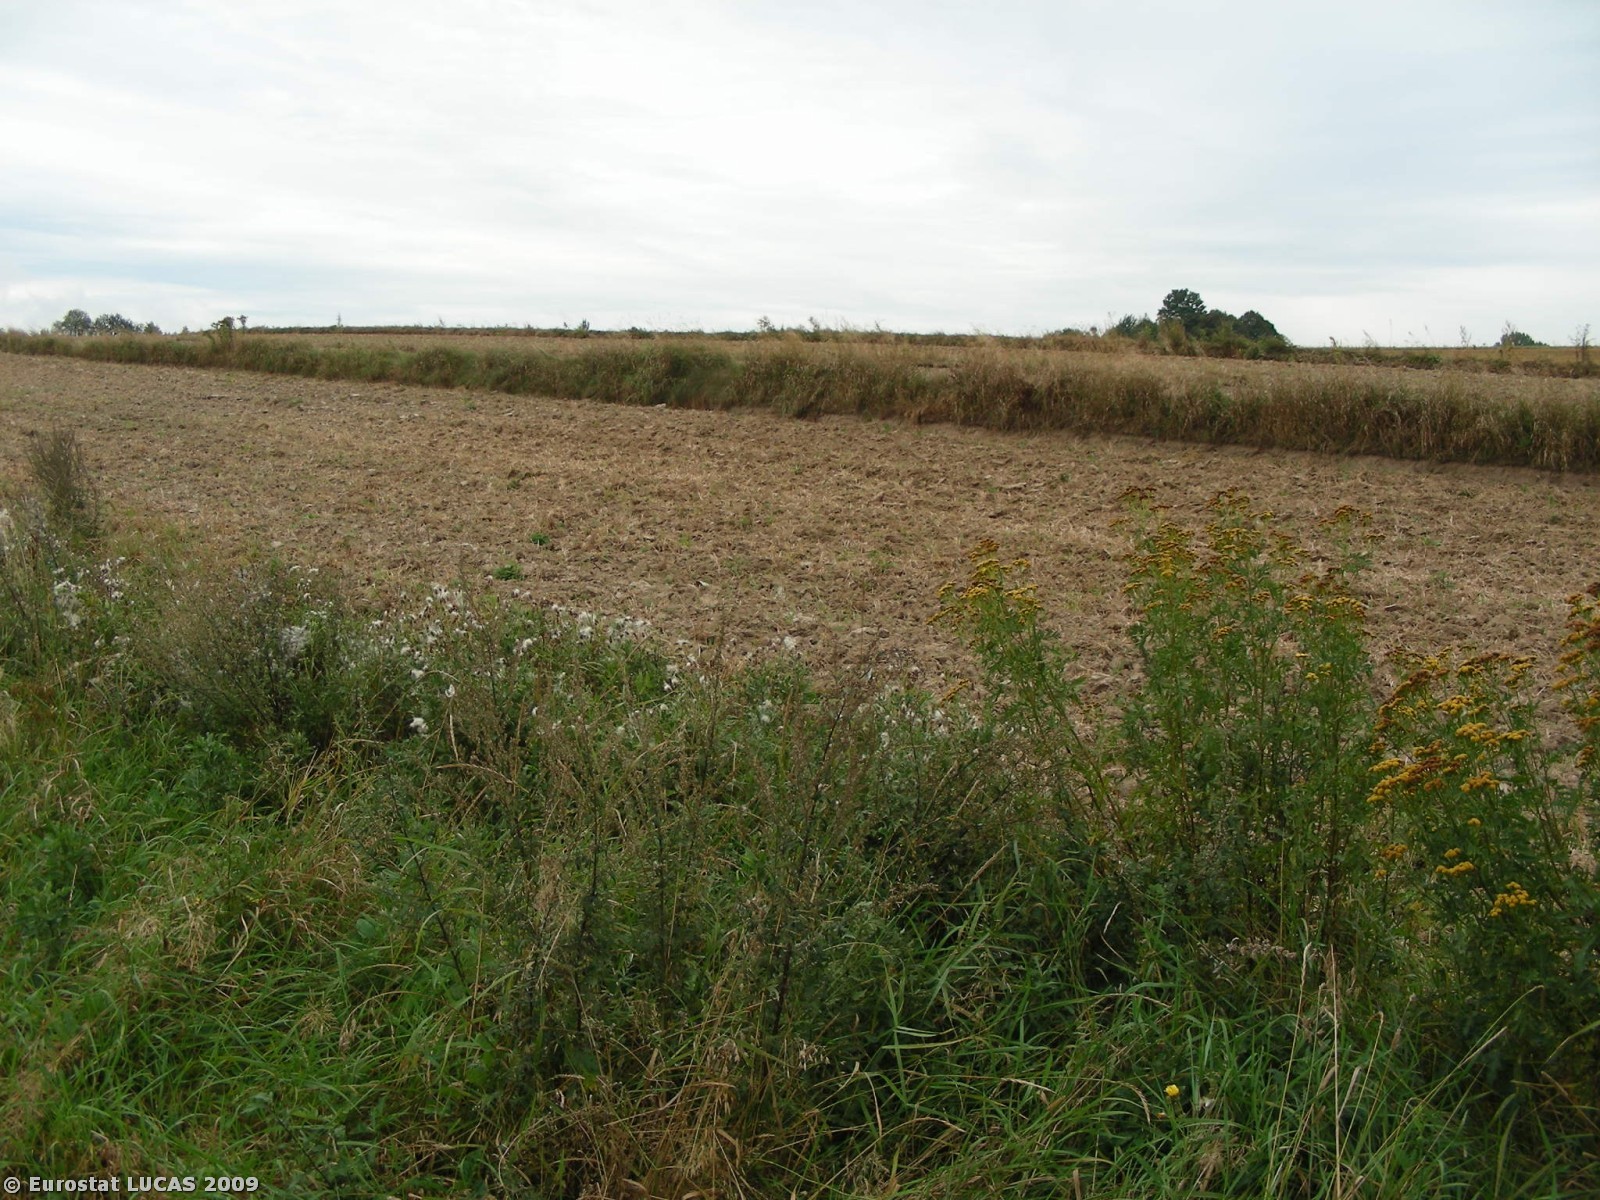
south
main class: Cropland
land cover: Common wheat
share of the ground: < 10 %
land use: Agriculture (excluding fallow land and kitchen gardens)
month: September
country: PL
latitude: 50.8413
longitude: 22.3188
